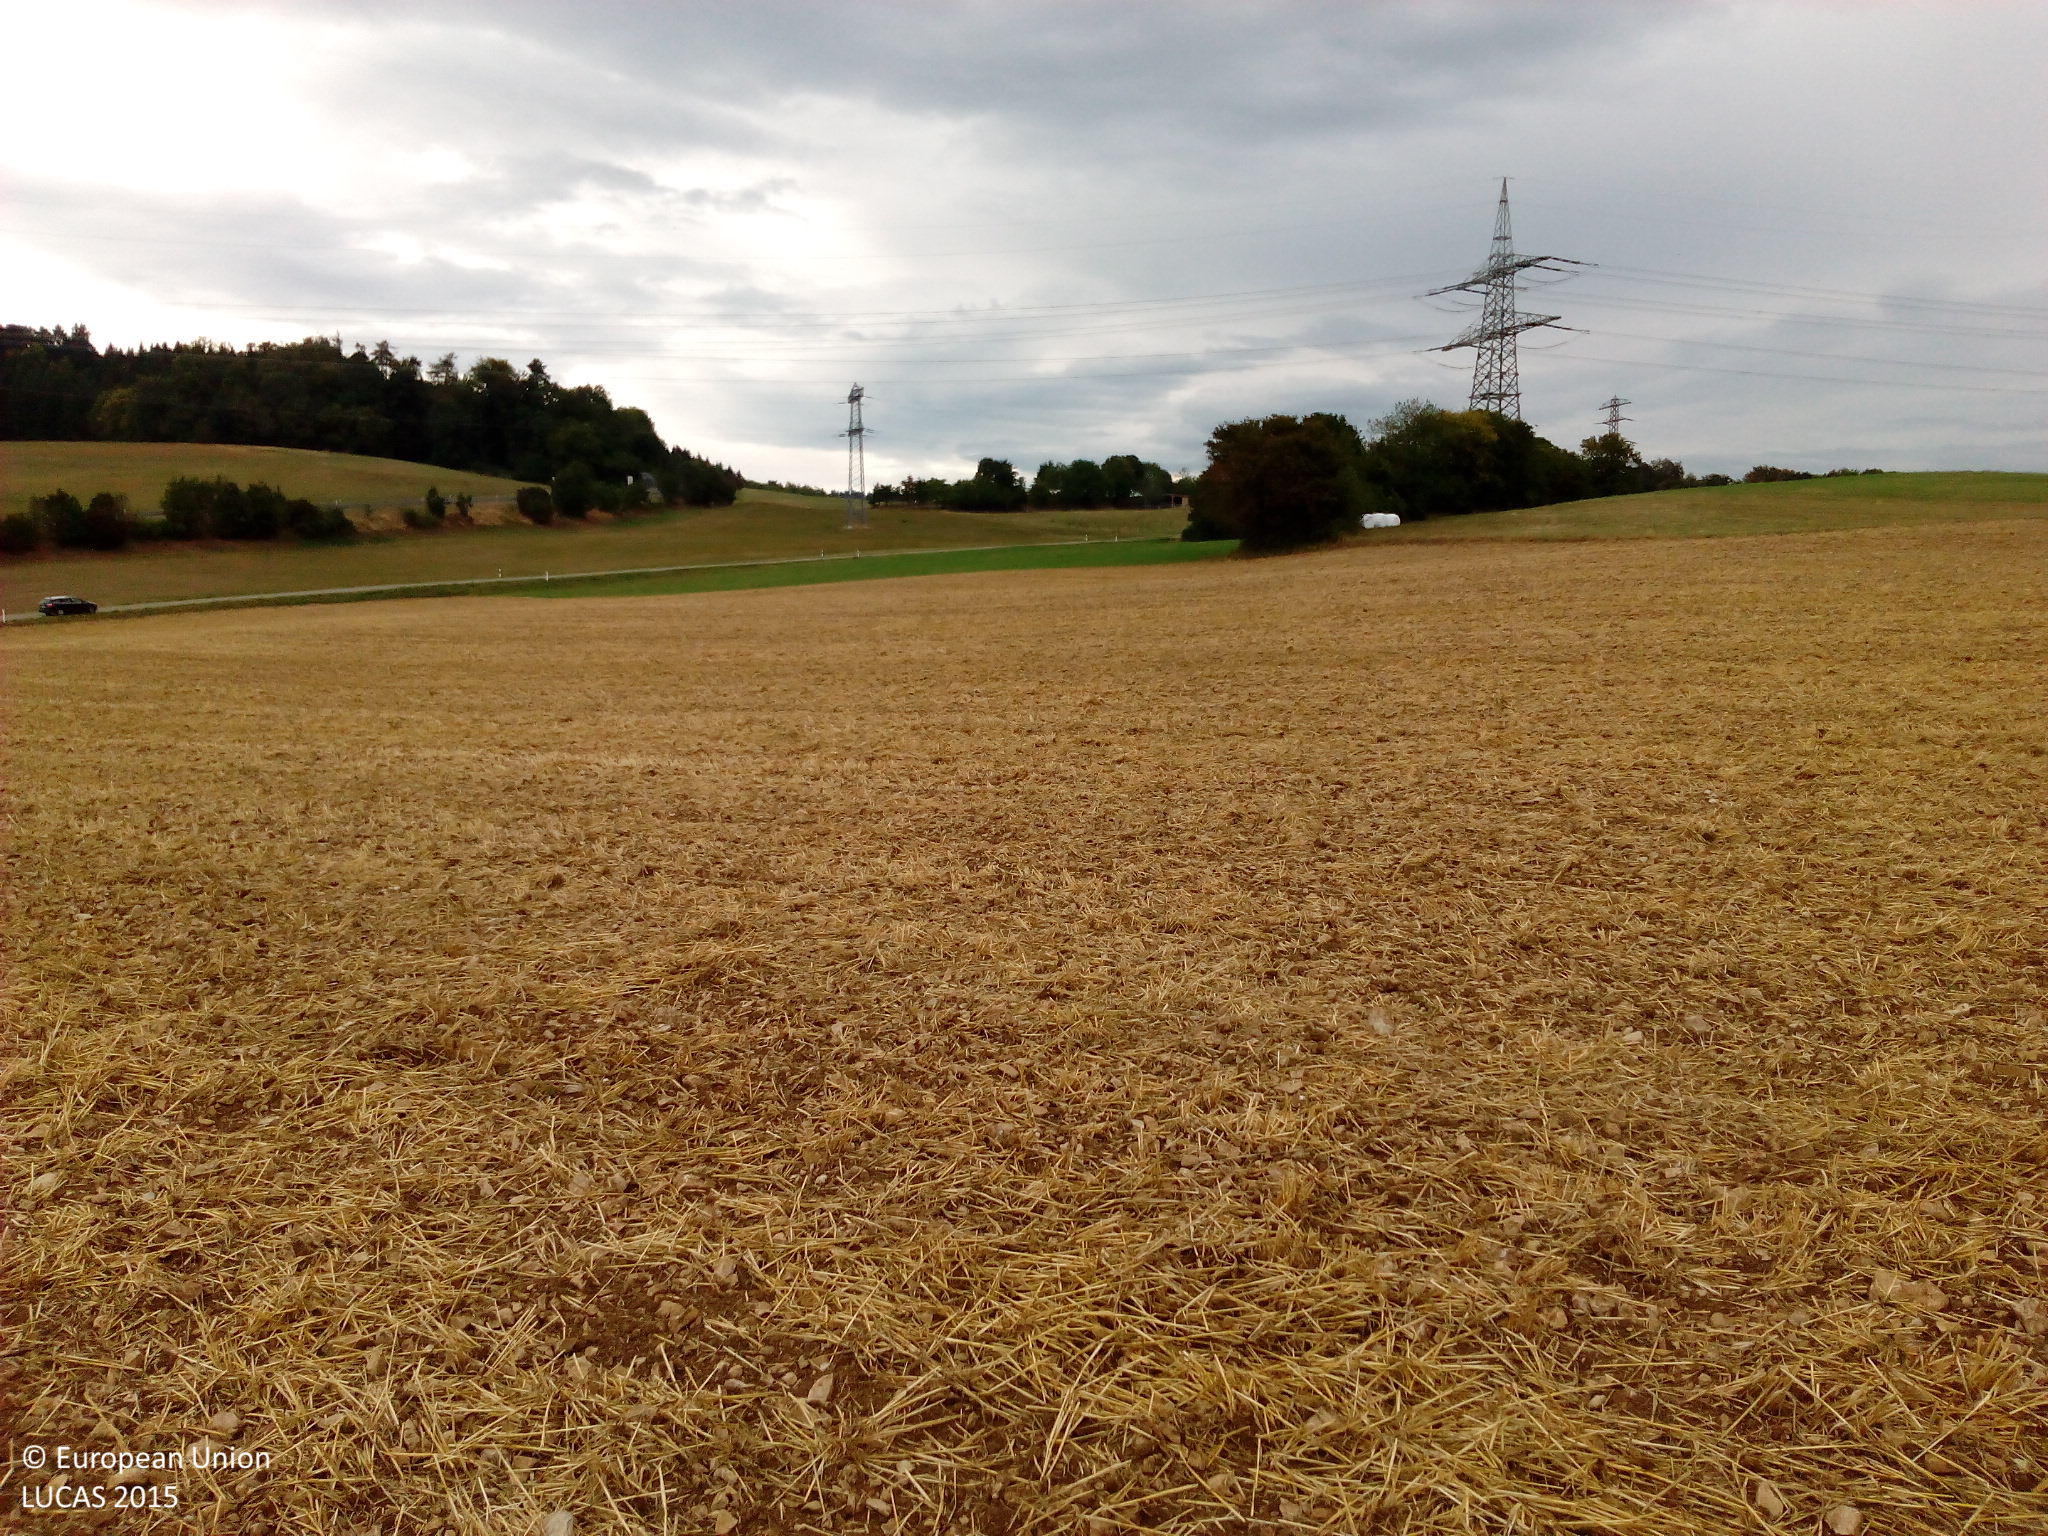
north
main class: Cropland
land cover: Common wheat
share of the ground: < 10 %
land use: Agriculture (excluding fallow land and kitchen gardens)
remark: Harvested field
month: August
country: DE
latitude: 47.6504
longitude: 8.1774
